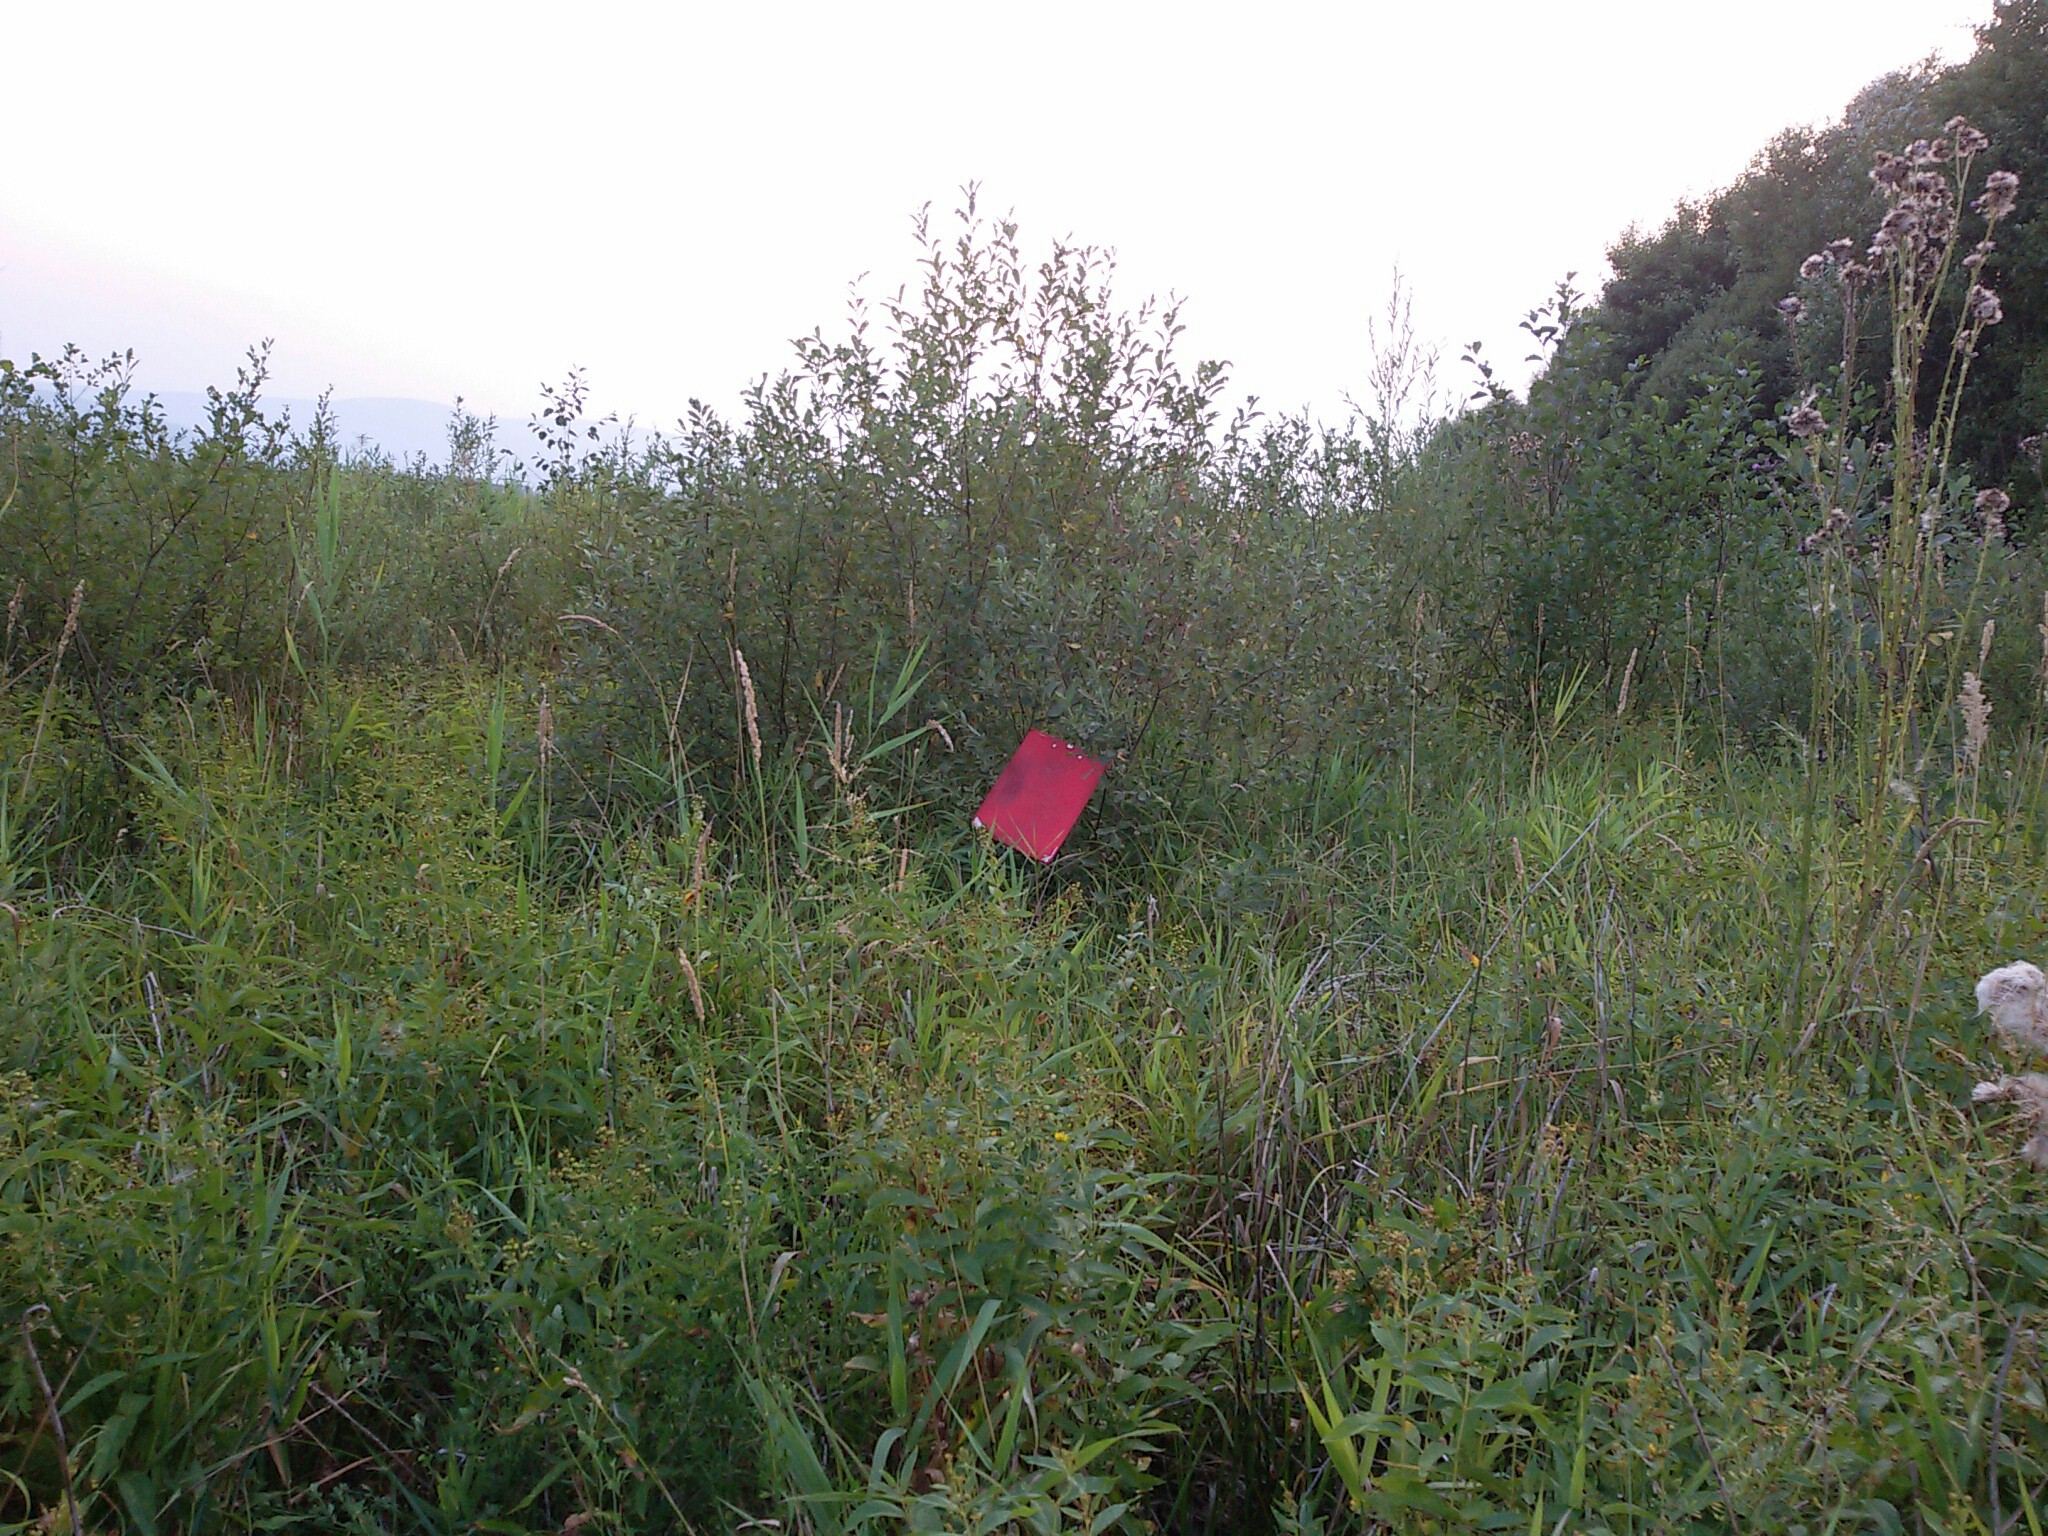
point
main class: Shrubland
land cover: Shrubland without tree cover
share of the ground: > 75 %
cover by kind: shrubs 90 %, herbaceous plants 10 %
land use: Semi-natural and natural areas not in use
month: August
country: PL
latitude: 50.9740
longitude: 15.4301
